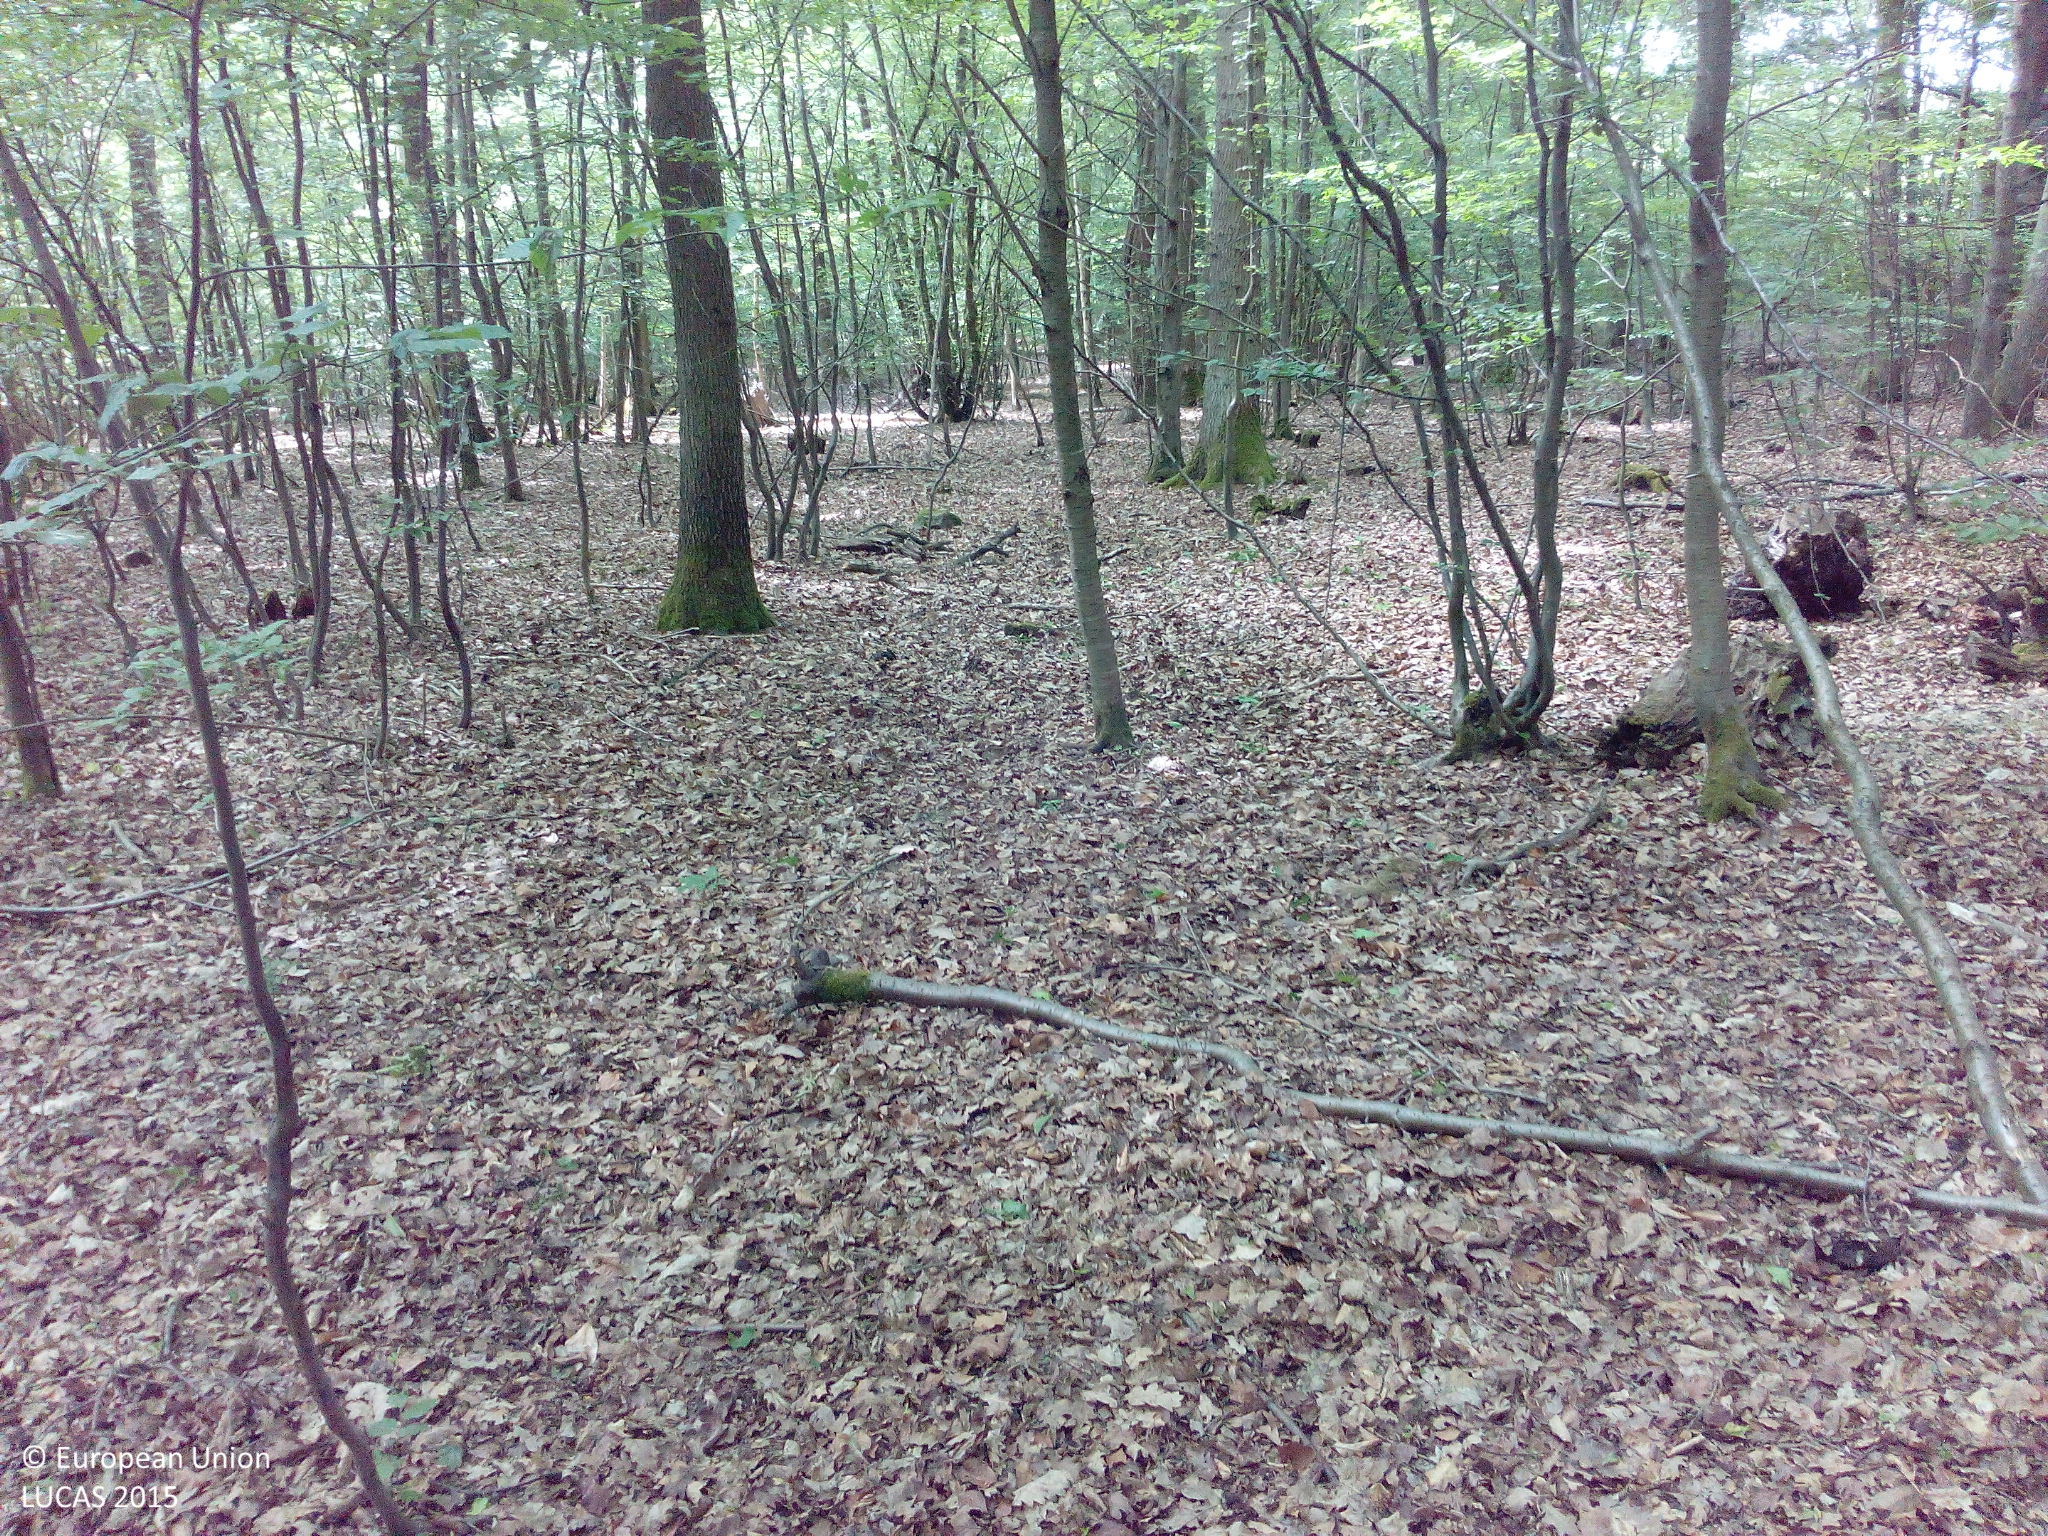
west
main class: Woodland
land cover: Broadleaved woodland
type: mesophytic deciduous forest
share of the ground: > 75 %
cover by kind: broadleaved forest trees 90 %, unconsolidated bare surface 10 %
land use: Forestry
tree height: > 5 m
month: June
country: DE
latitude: 50.3376
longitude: 8.6094
